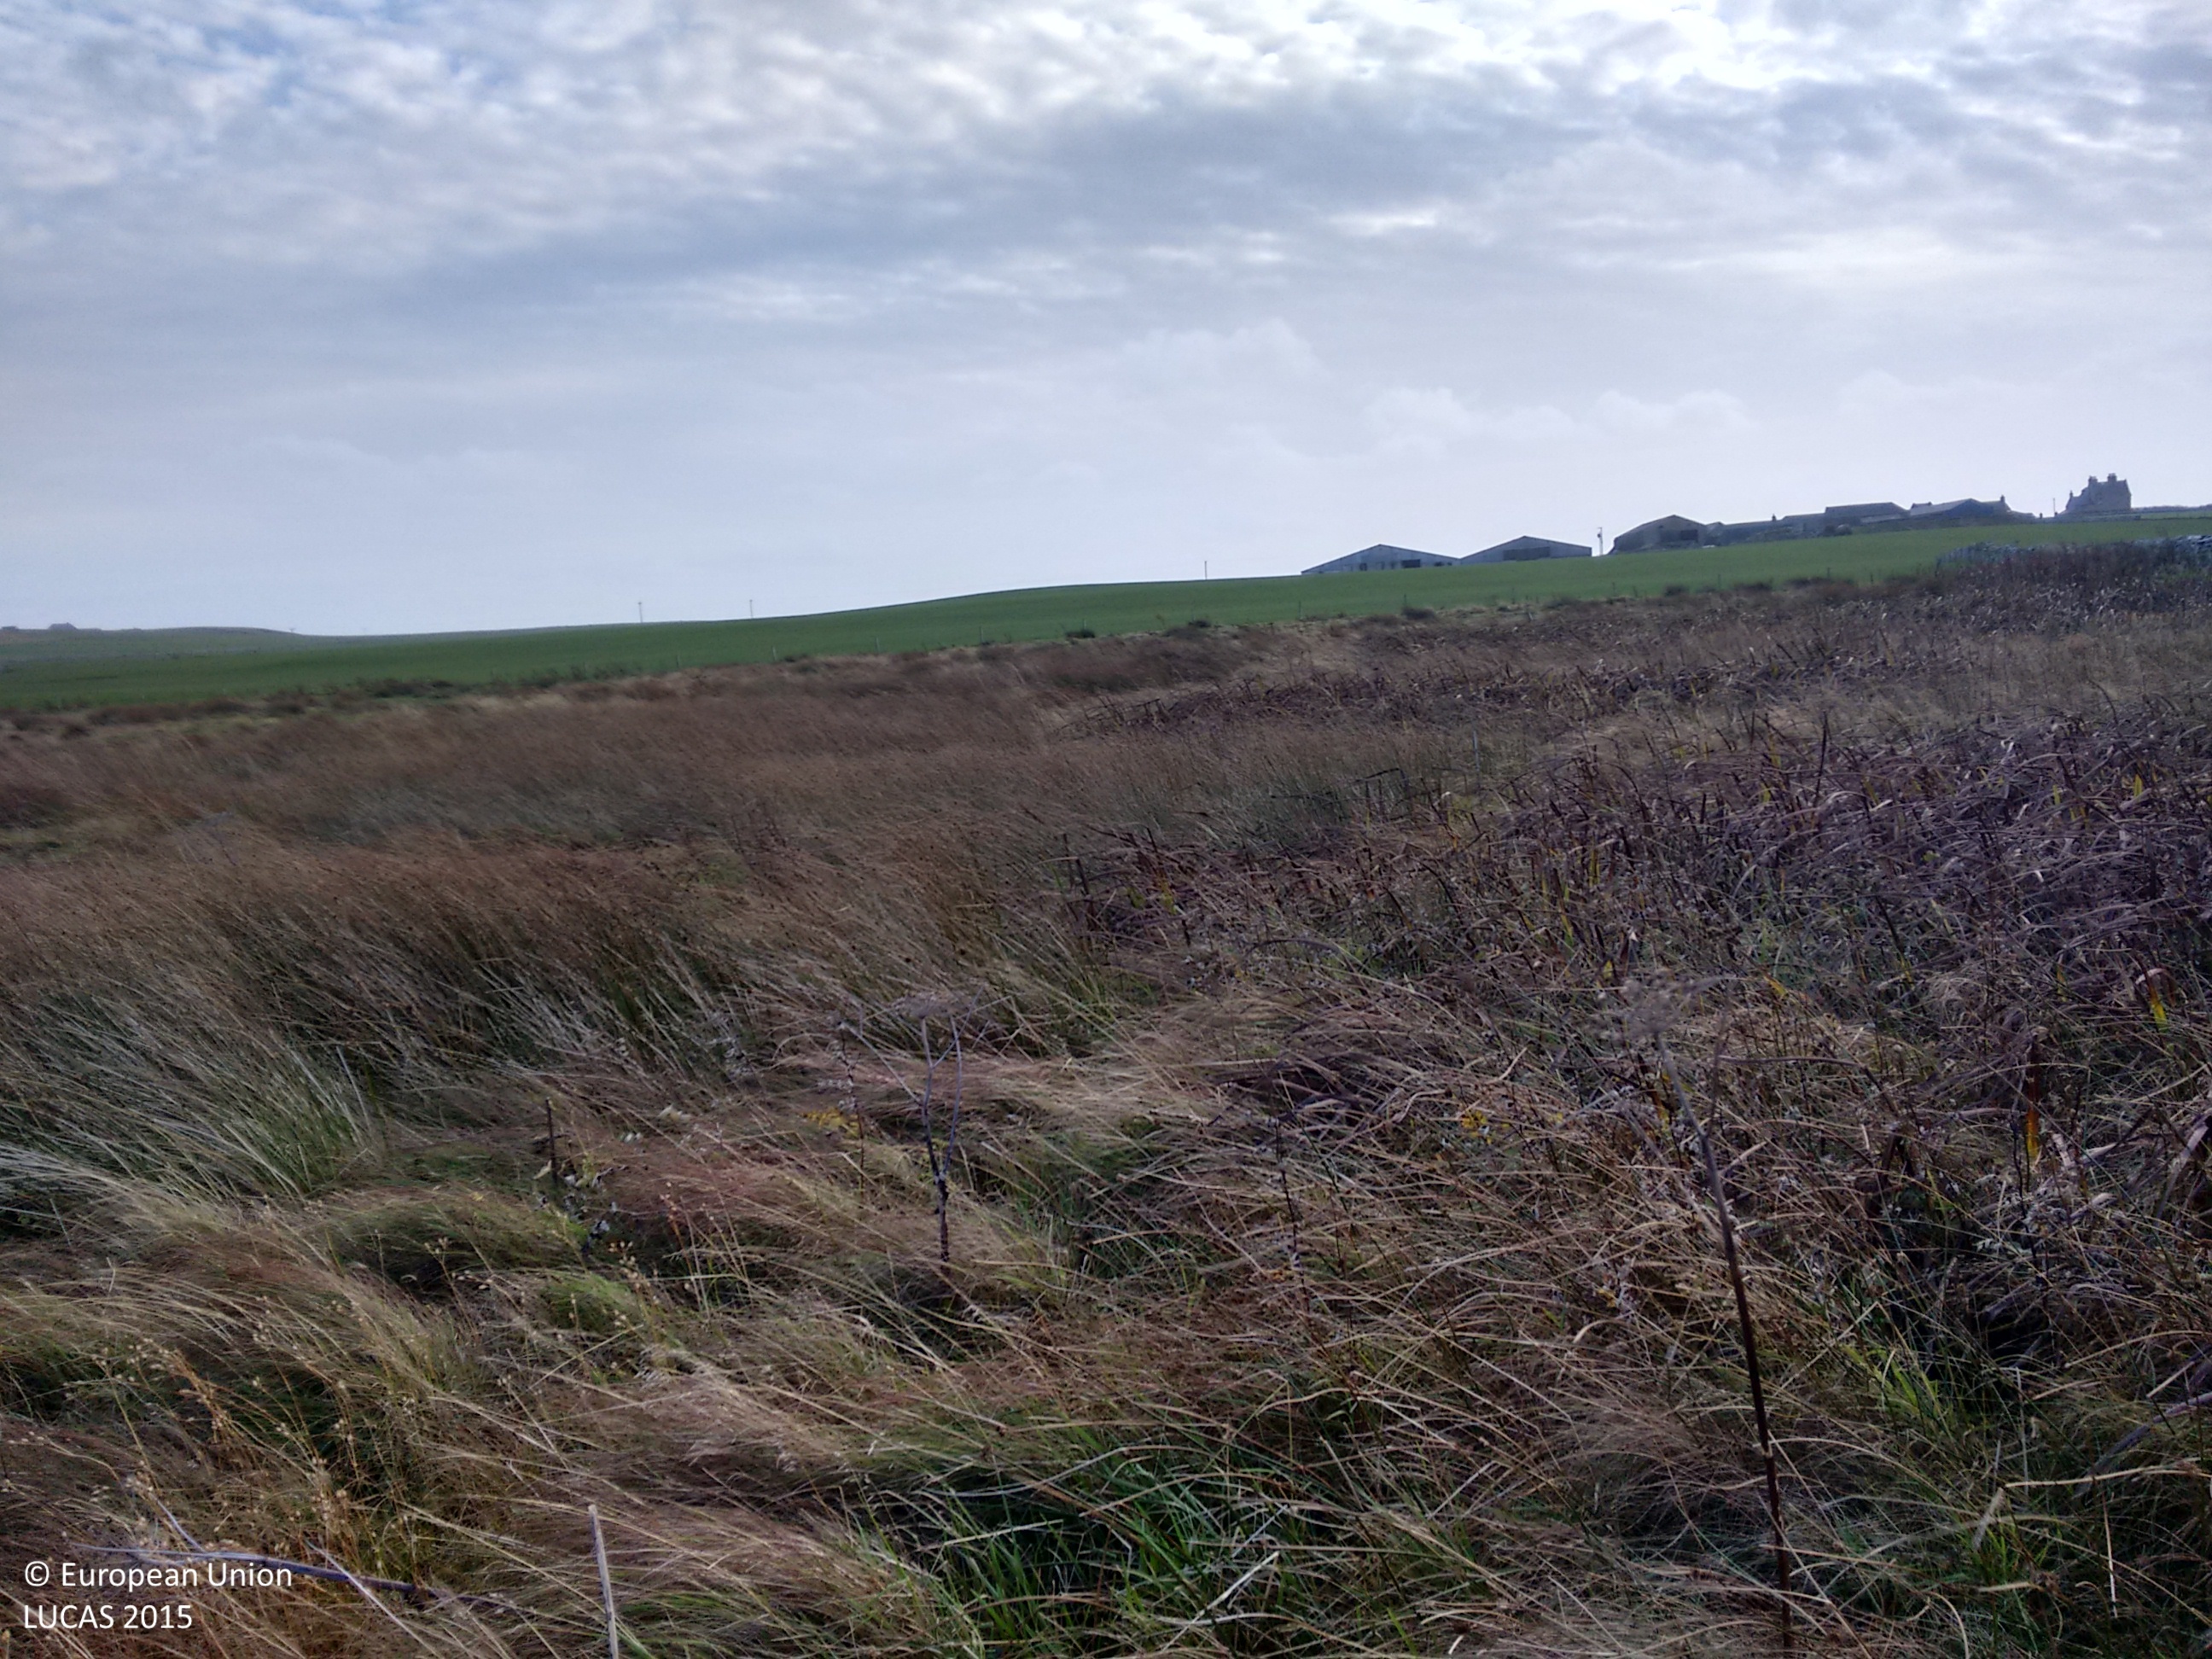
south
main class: Grassland
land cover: Grassland without tree/shrub cover
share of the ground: > 75 %
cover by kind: herbaceous plants 100 %
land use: Agriculture (excluding fallow land and kitchen gardens)
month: November
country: GB
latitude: 58.9381
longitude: -2.7860
